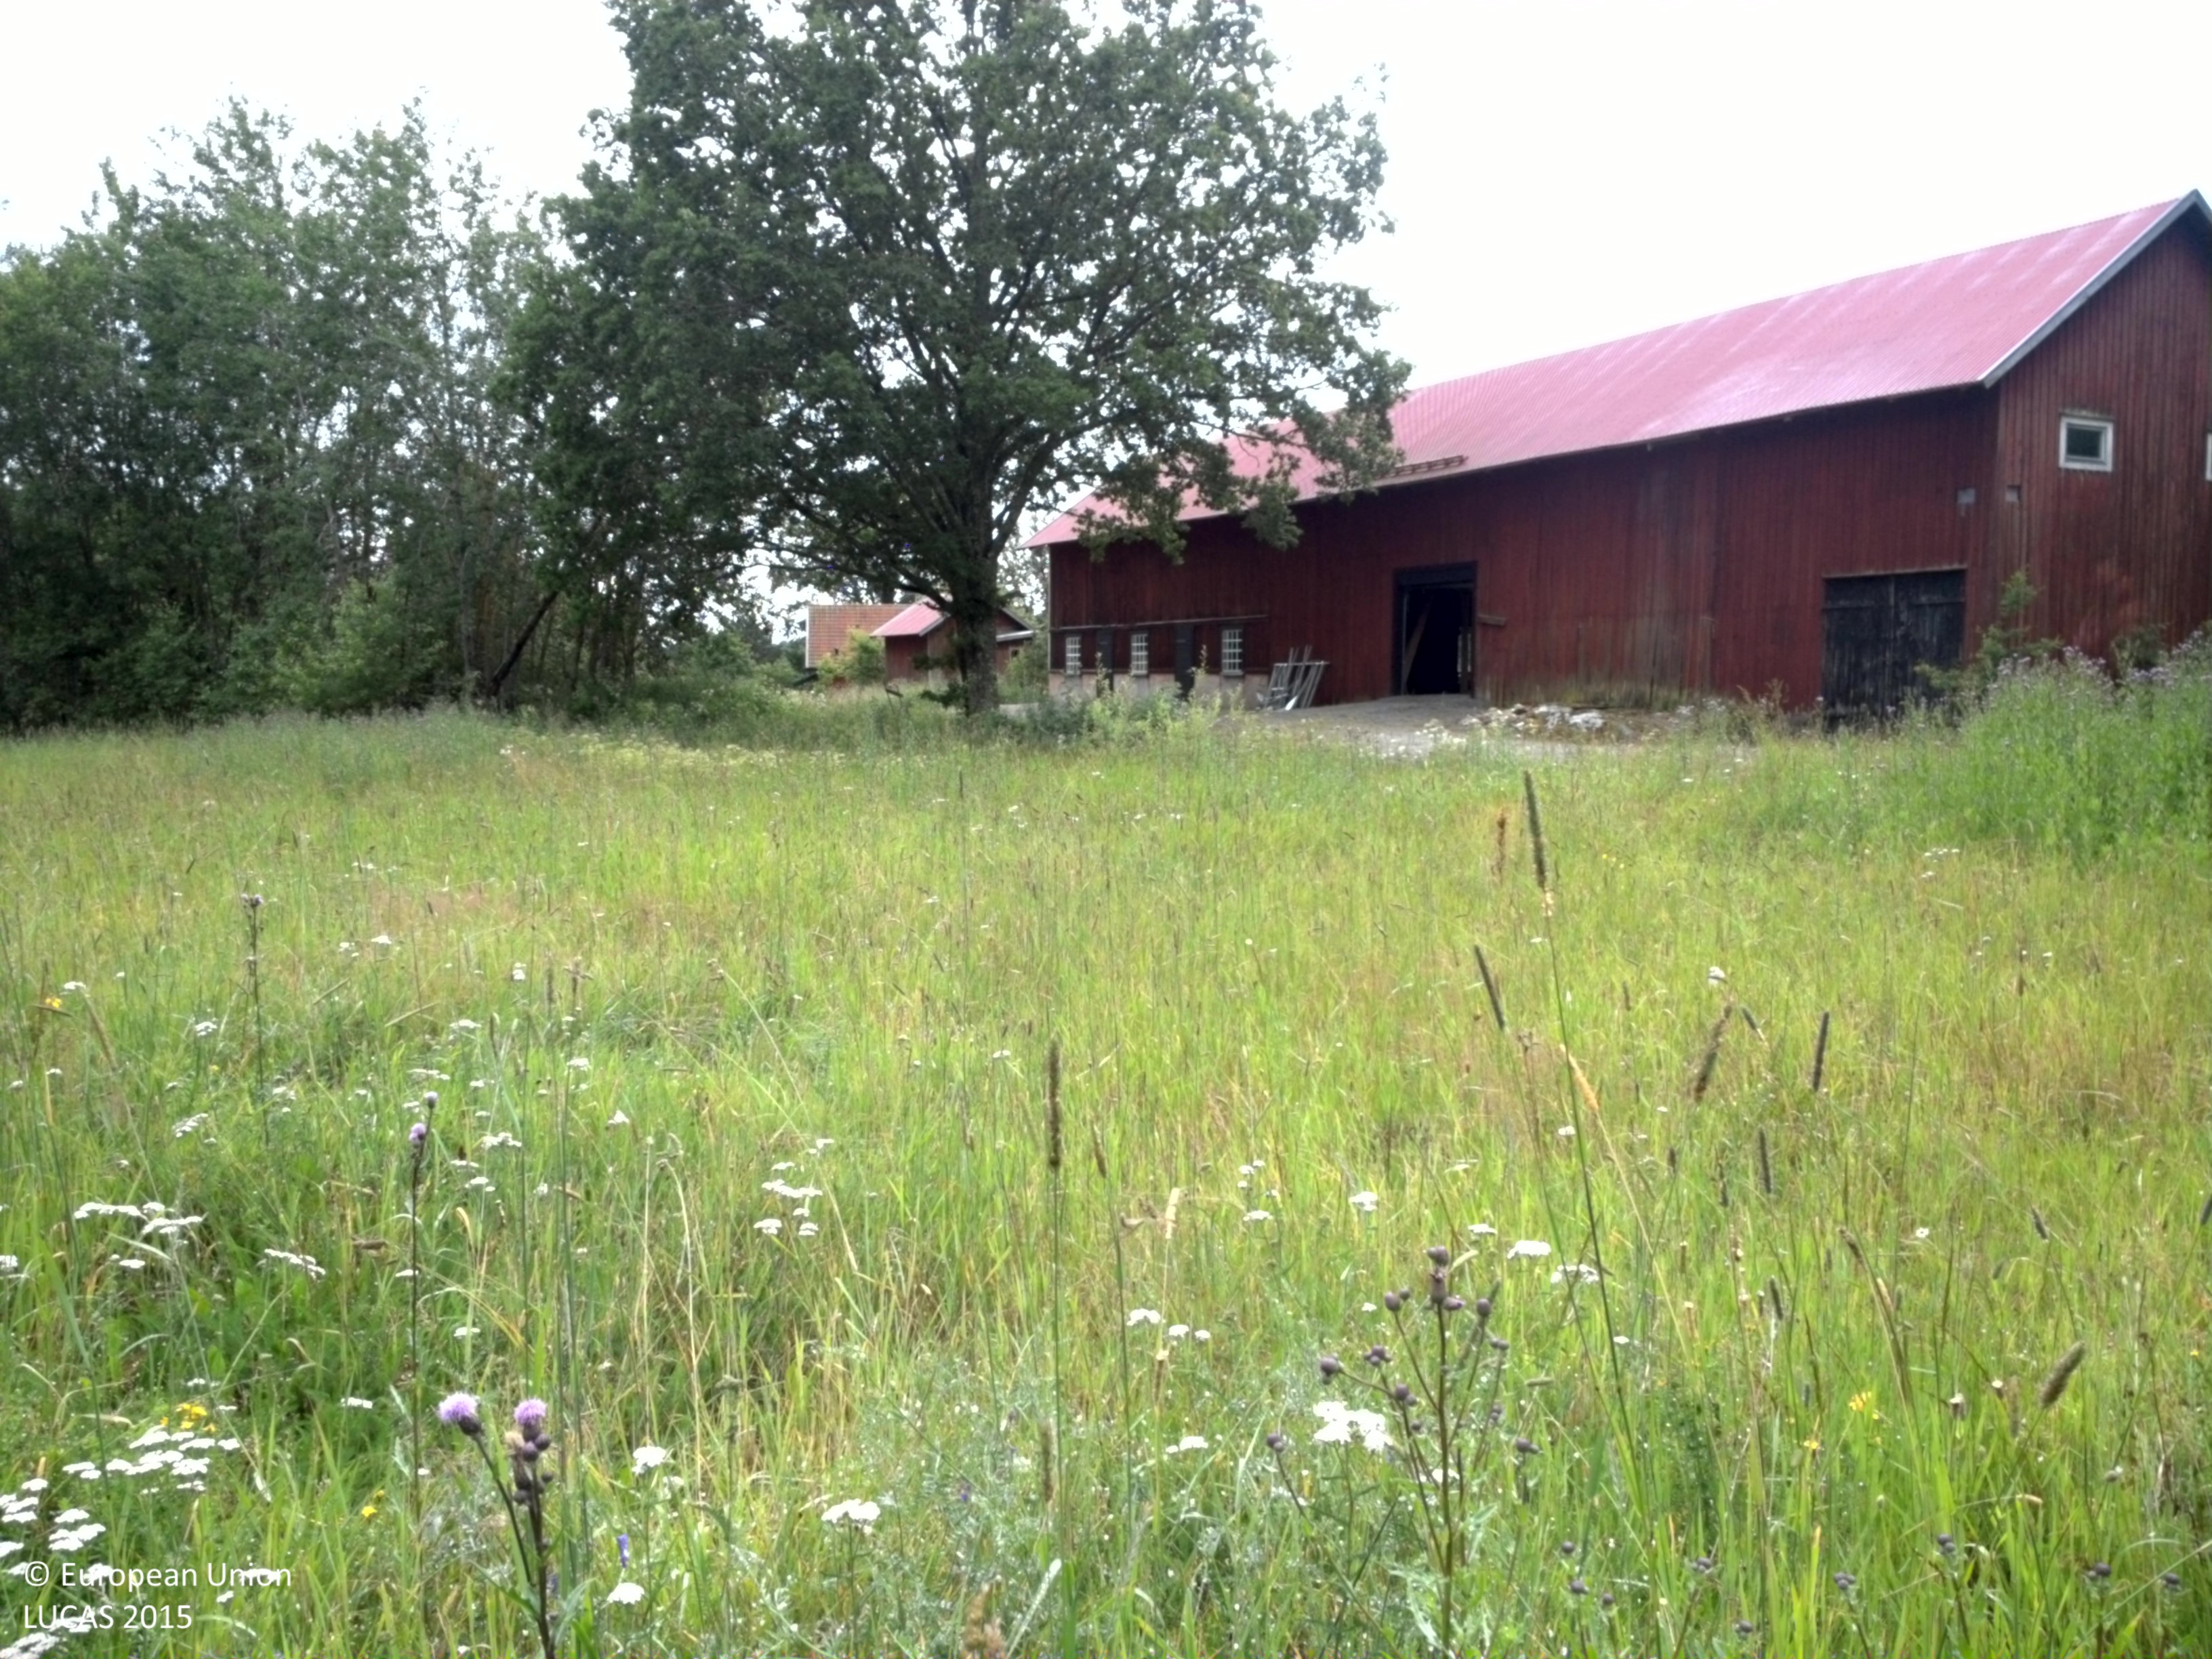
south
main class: Grassland
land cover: Grassland without tree/shrub cover
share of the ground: > 75 %
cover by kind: herbaceous plants 100 %
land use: Semi-natural and natural areas not in use
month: July
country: SE
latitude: 59.5966
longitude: 18.5206
